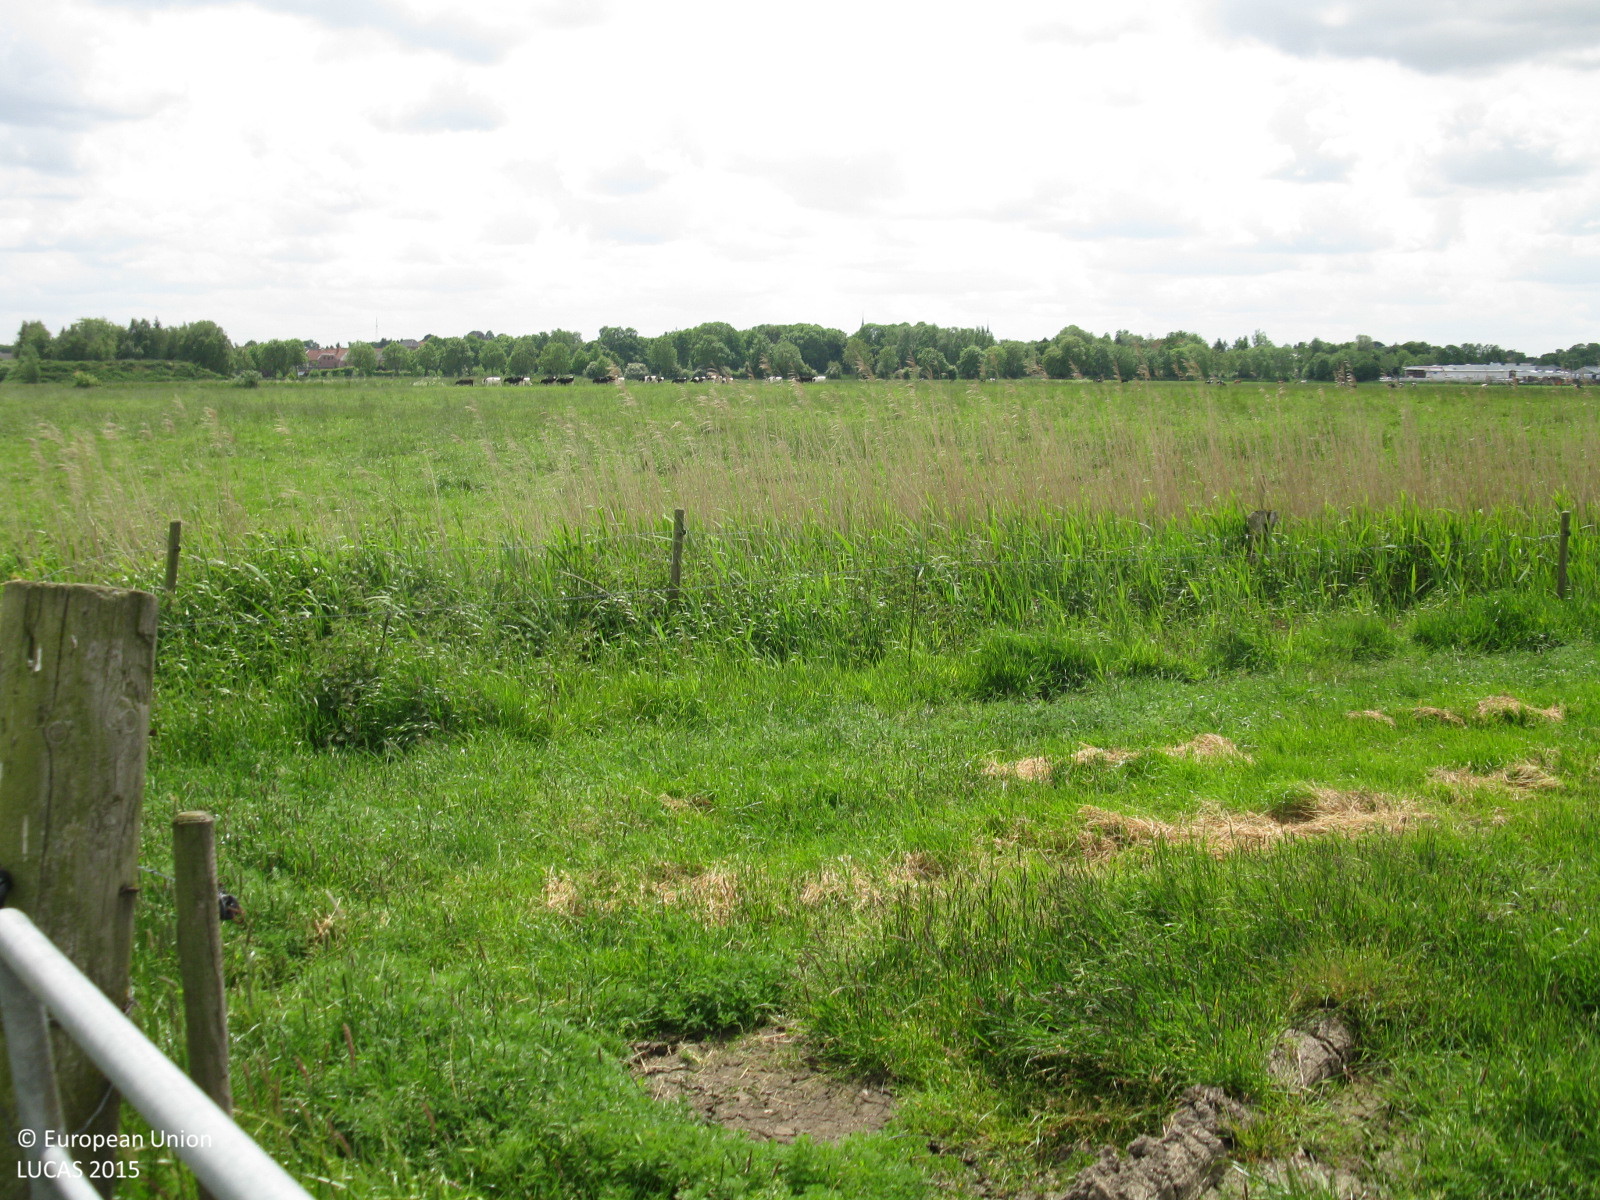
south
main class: Grassland
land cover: Grassland without tree/shrub cover
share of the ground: > 75 %
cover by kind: herbaceous plants 100 %
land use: Agriculture (excluding fallow land and kitchen gardens)
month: June
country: DE
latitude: 53.1752
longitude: 7.3524
